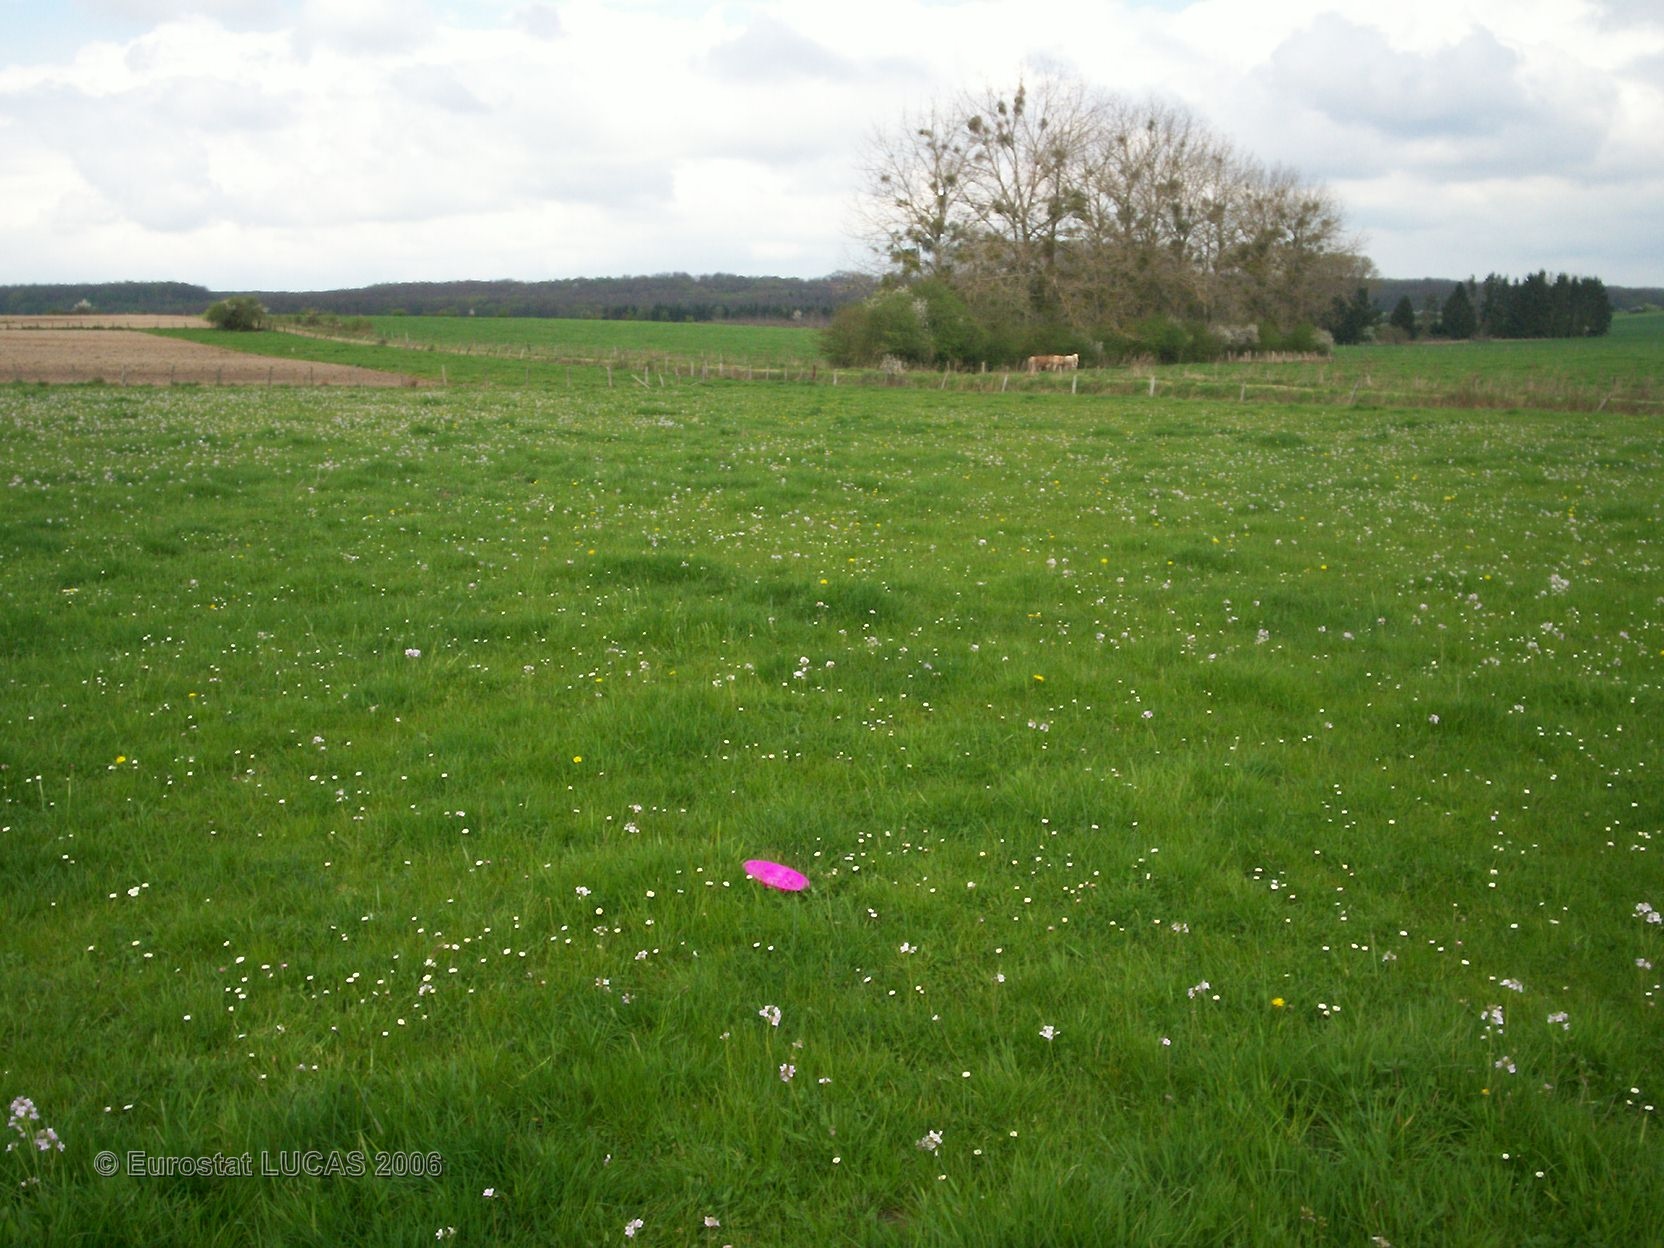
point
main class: Grassland
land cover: Grassland without tree/shrub cover
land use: Agriculture (excluding fallow land and kitchen gardens)
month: April
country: FR
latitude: 48.7535
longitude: 6.8041
